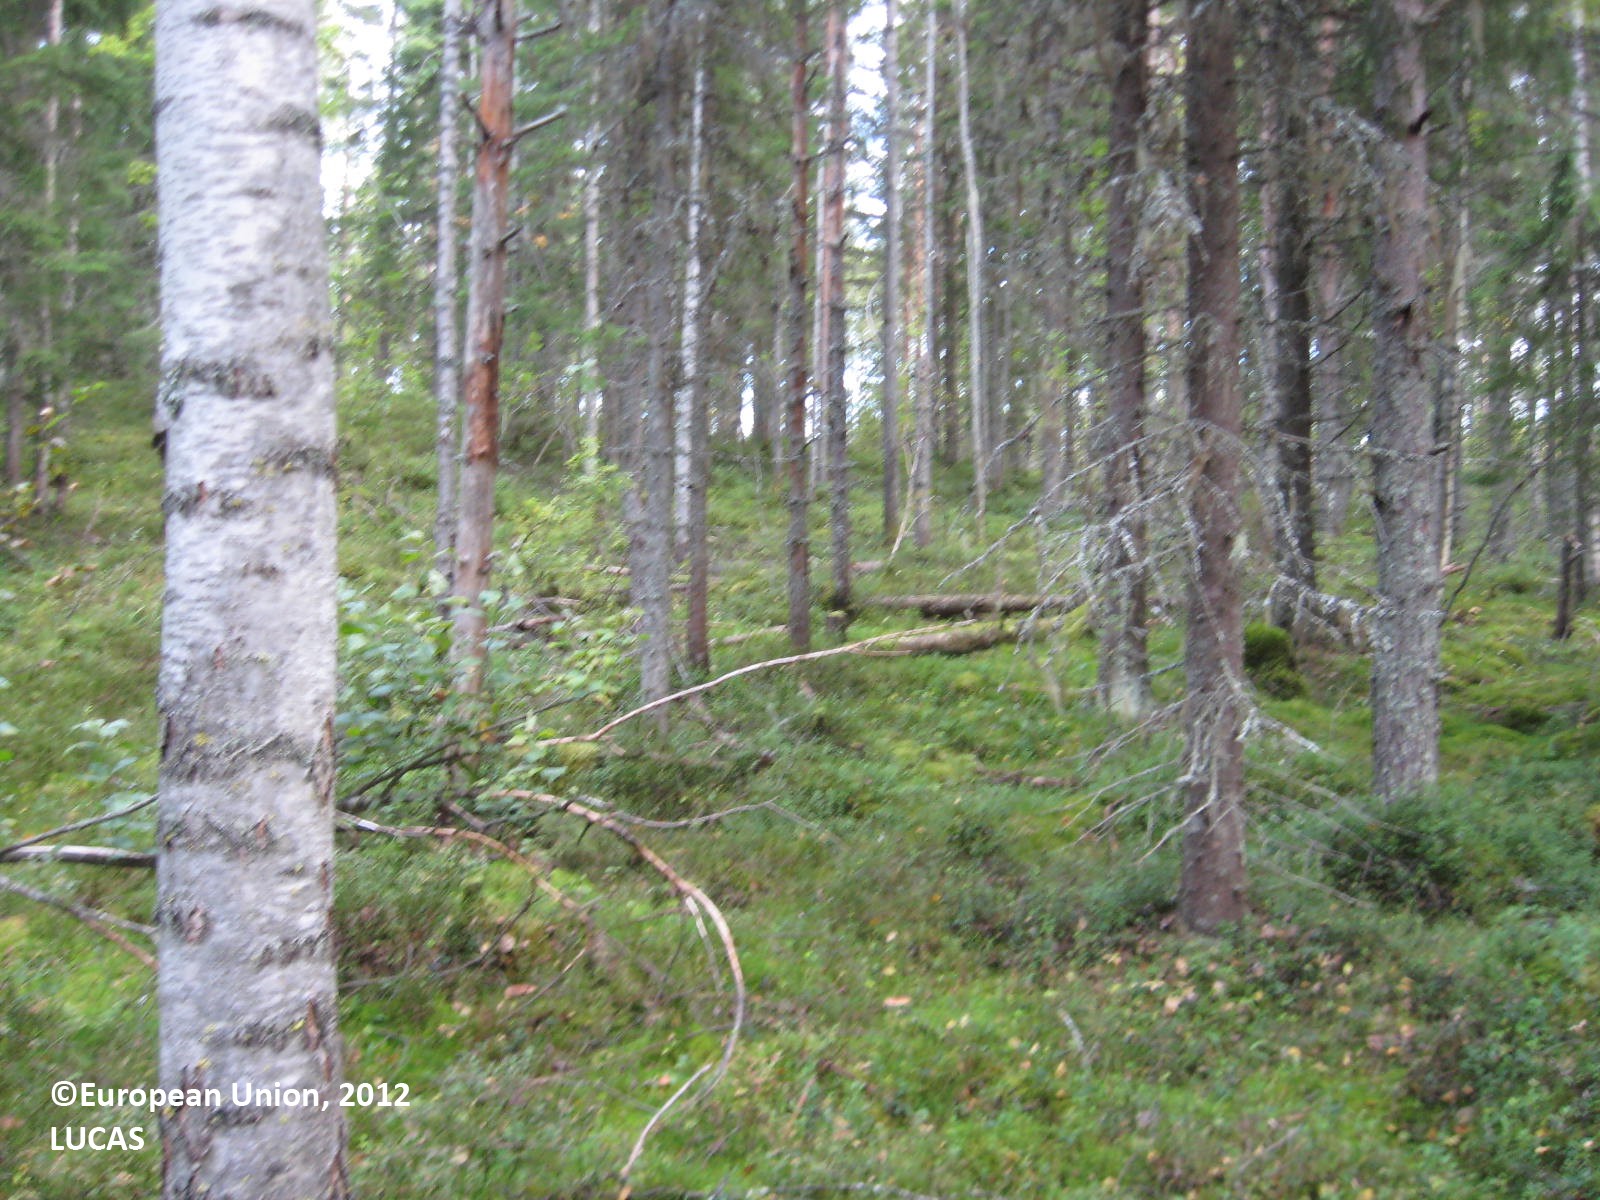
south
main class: Woodland
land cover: Spruce dominated mixed woodland
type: boreal forest
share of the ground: > 75 %
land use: Forestry
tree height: > 5 m
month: August
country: FI
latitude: 63.7319
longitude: 29.4832
